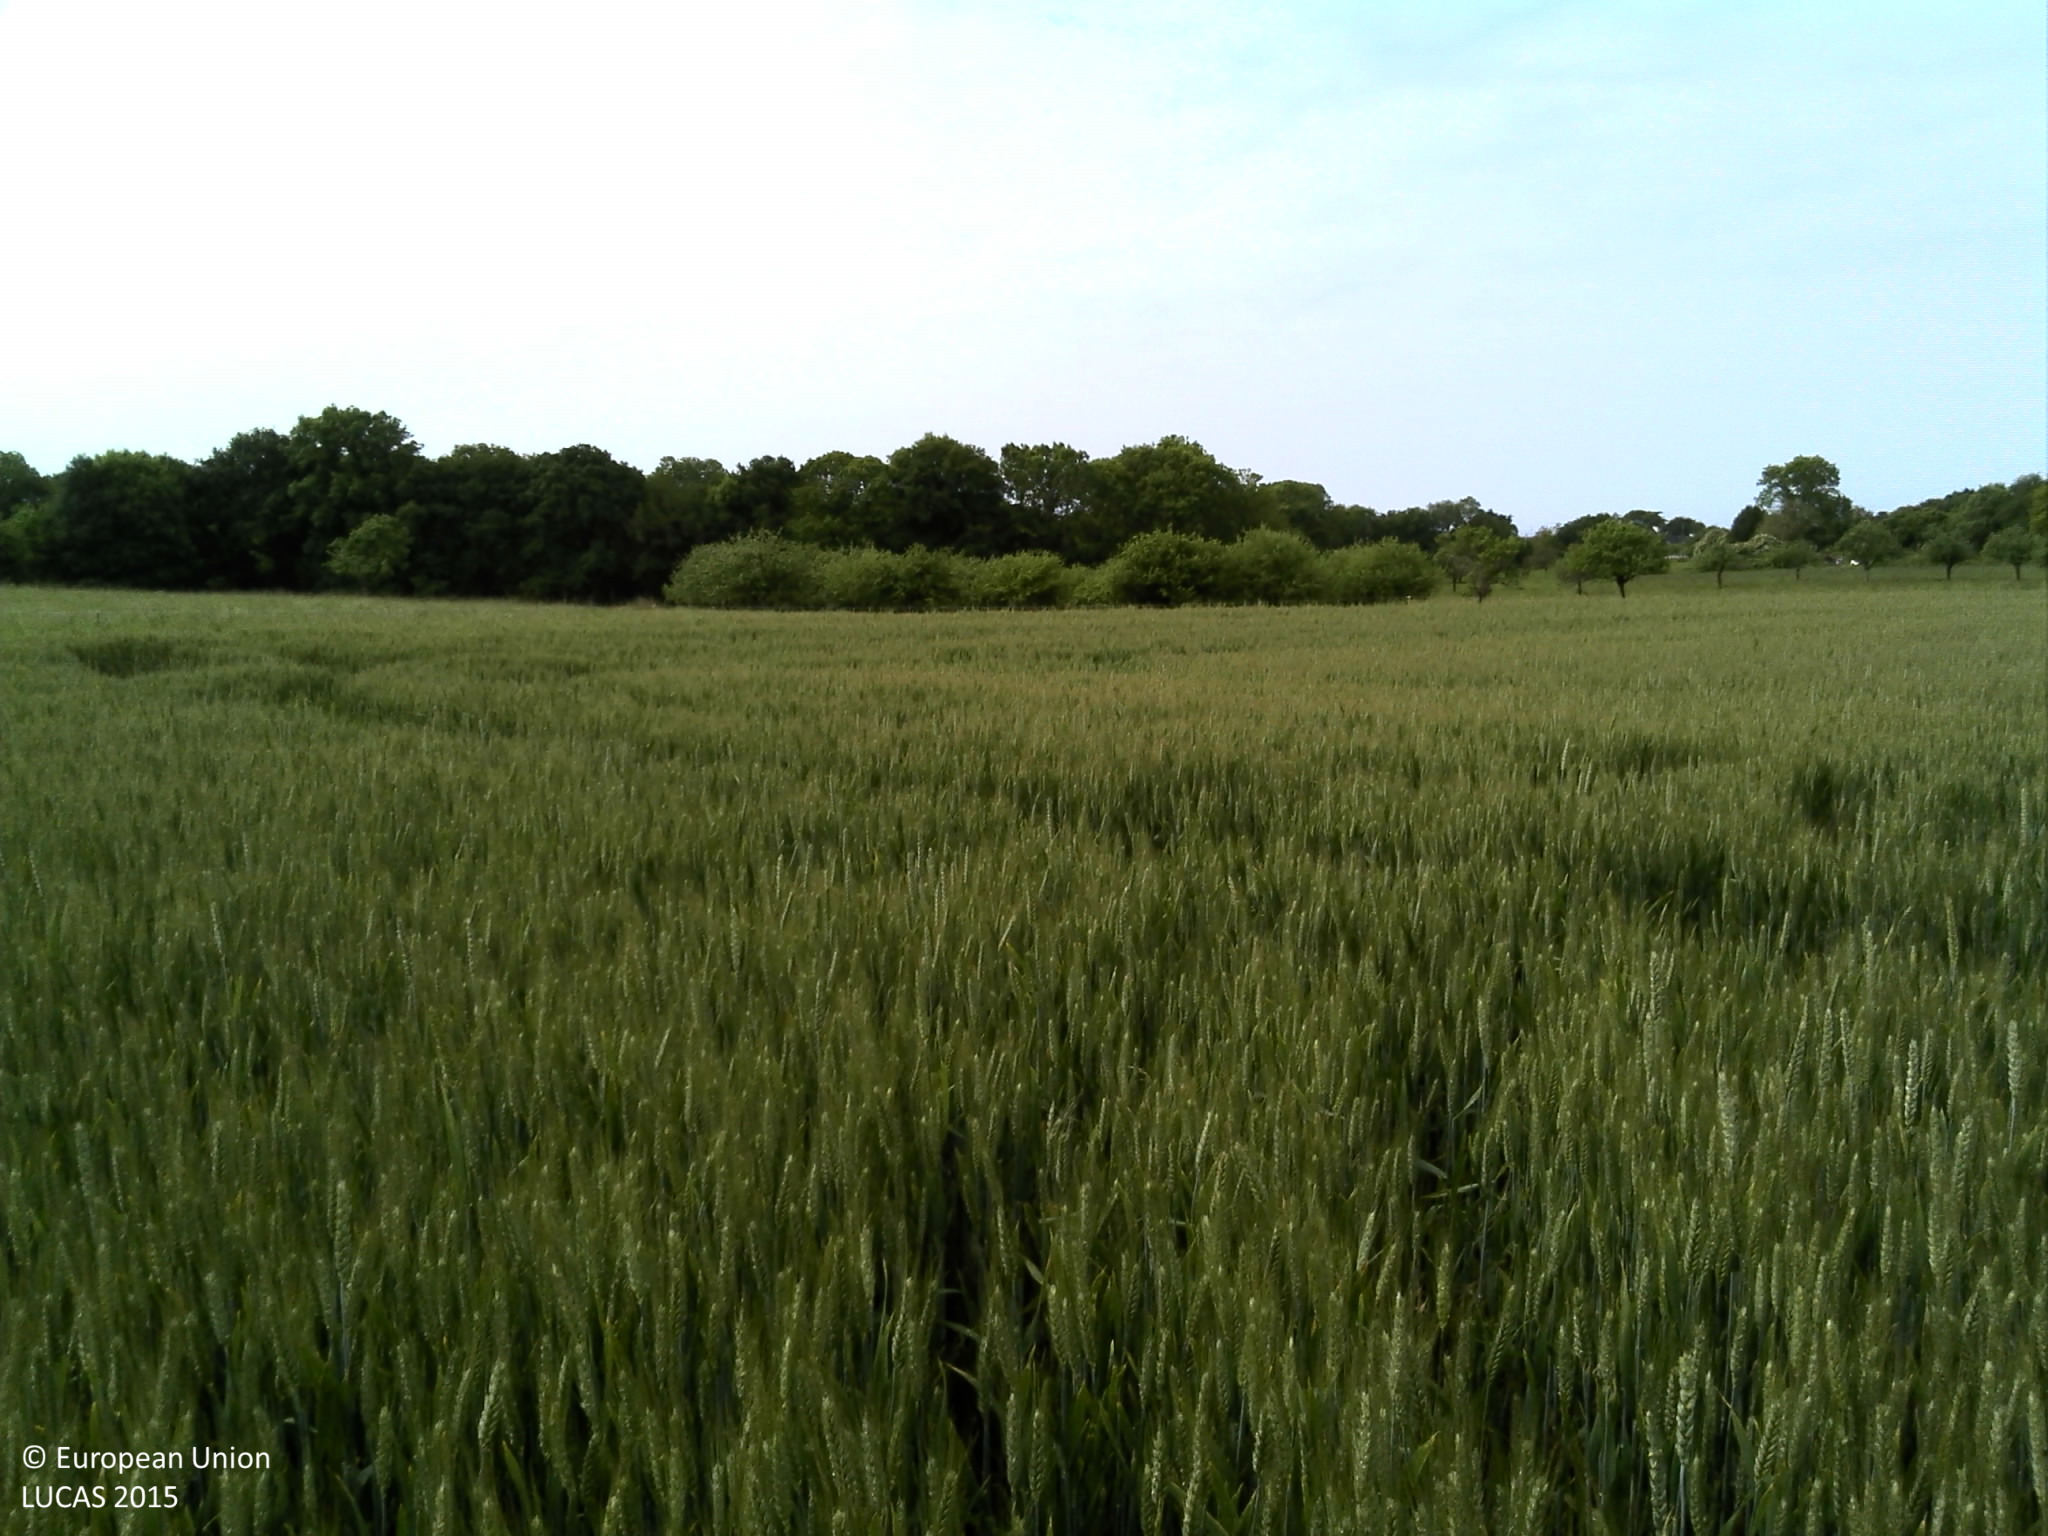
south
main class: Cropland
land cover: Common wheat
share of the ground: > 75 %
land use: Agriculture (excluding fallow land and kitchen gardens)
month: June
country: FR
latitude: 47.7810
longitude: -3.5699
